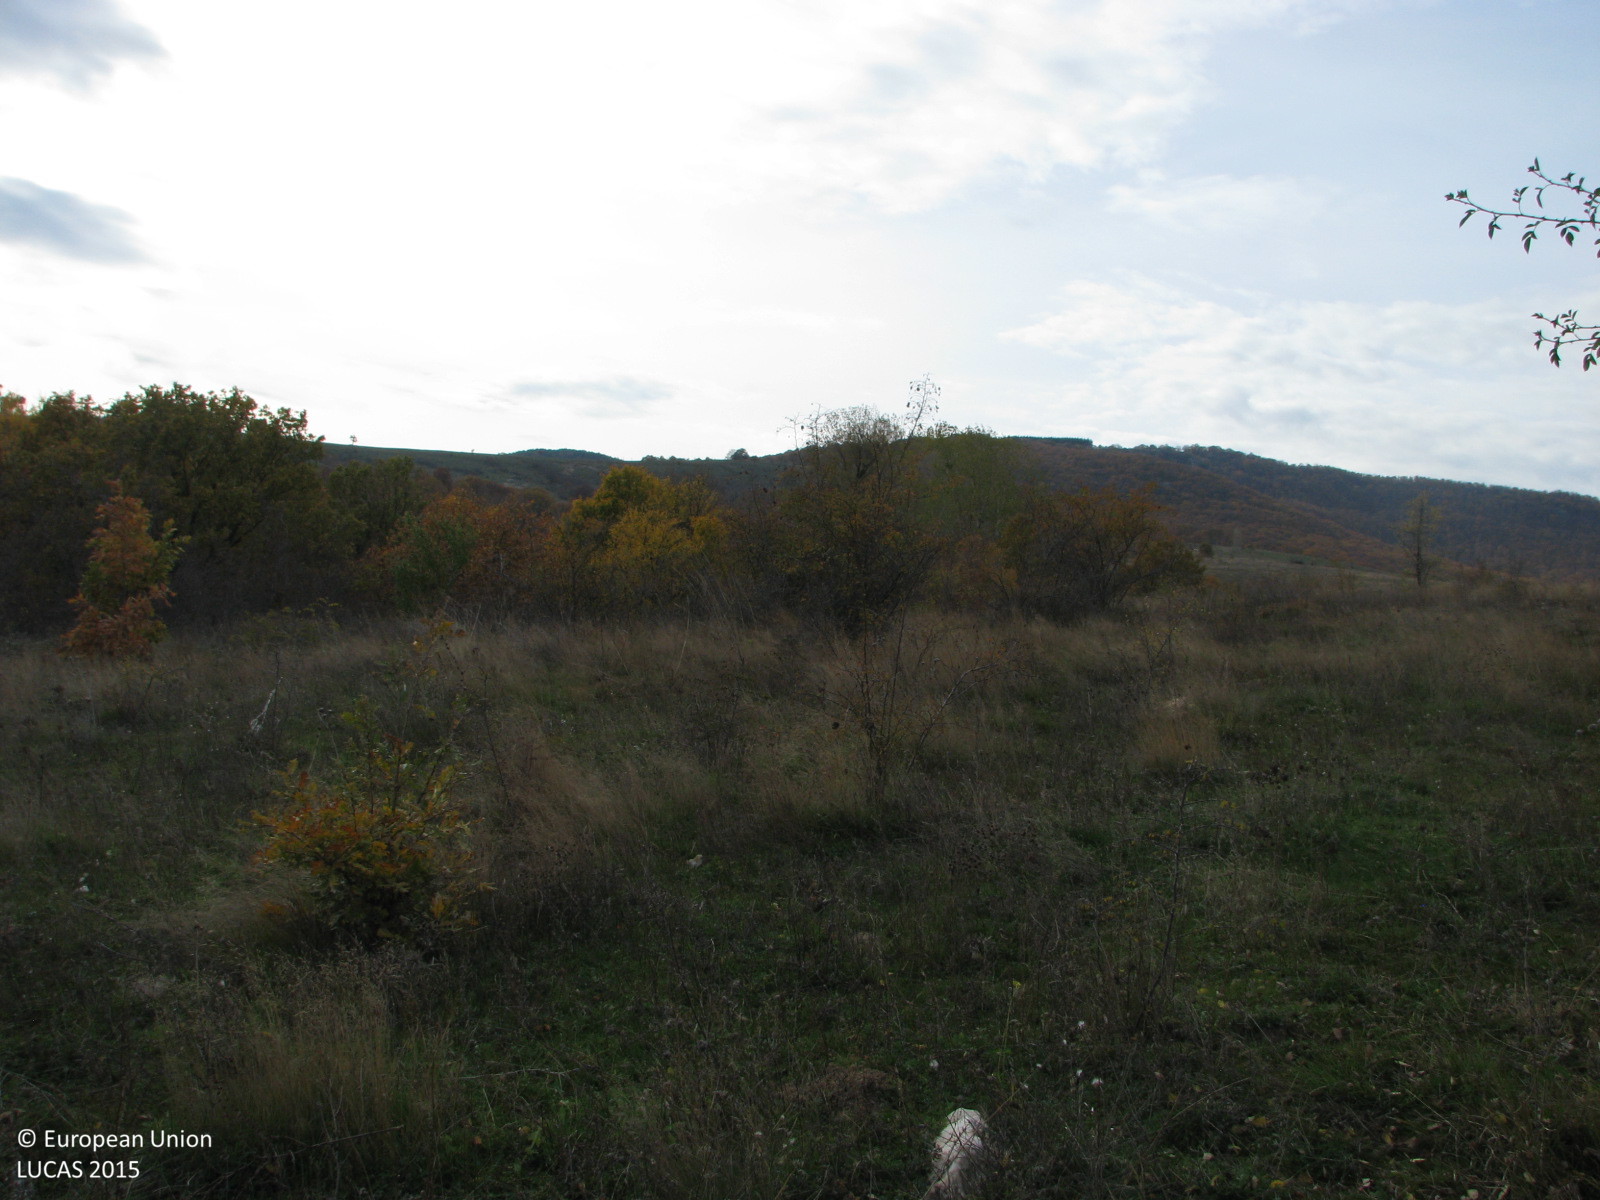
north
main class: Grassland
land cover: Grassland with sparse tree/shrub cover
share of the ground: > 75 %
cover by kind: herbaceous plants 85 %, shrubs 10 %, broadleaved forest trees 5 %
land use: Agriculture (excluding fallow land and kitchen gardens)
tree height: < 5 m
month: November
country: BG
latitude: 41.9710
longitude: 26.3856
